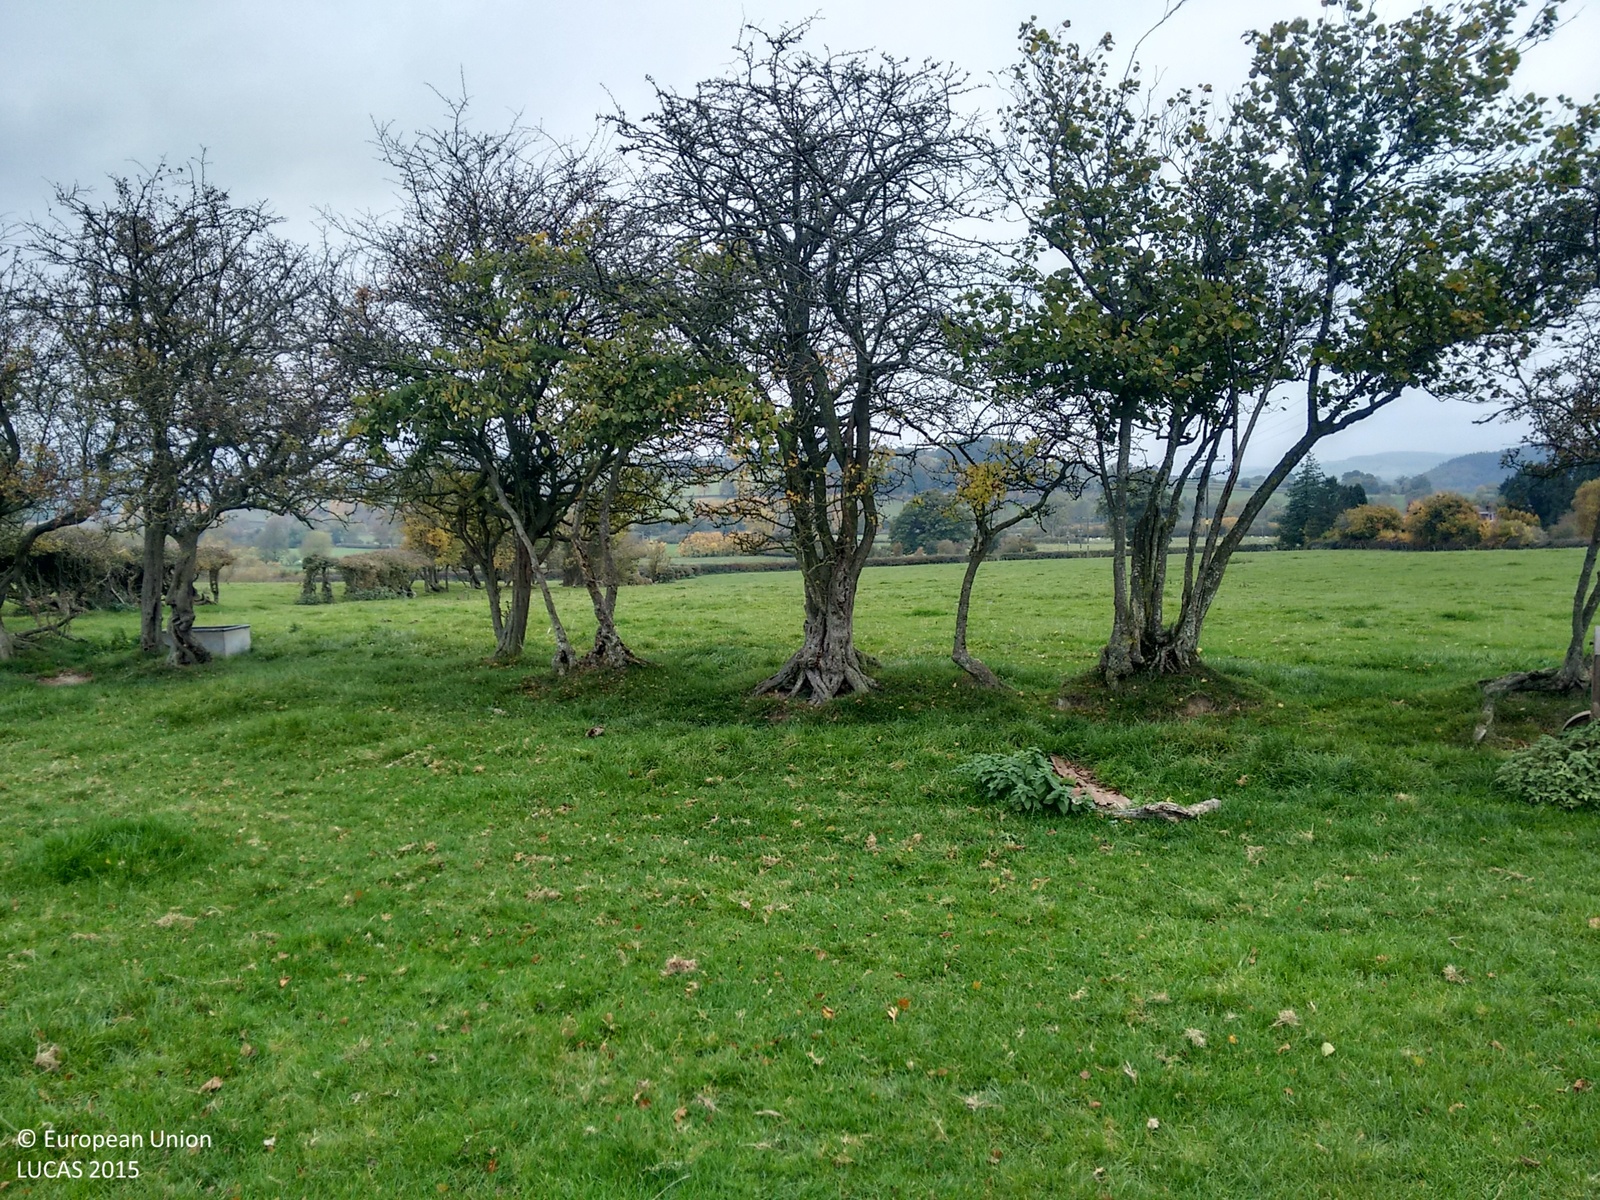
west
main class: Grassland
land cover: Grassland without tree/shrub cover
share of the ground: > 75 %
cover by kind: herbaceous plants 100 %
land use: Agriculture (excluding fallow land and kitchen gardens)
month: October
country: GB
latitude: 52.4189
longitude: -2.8798
